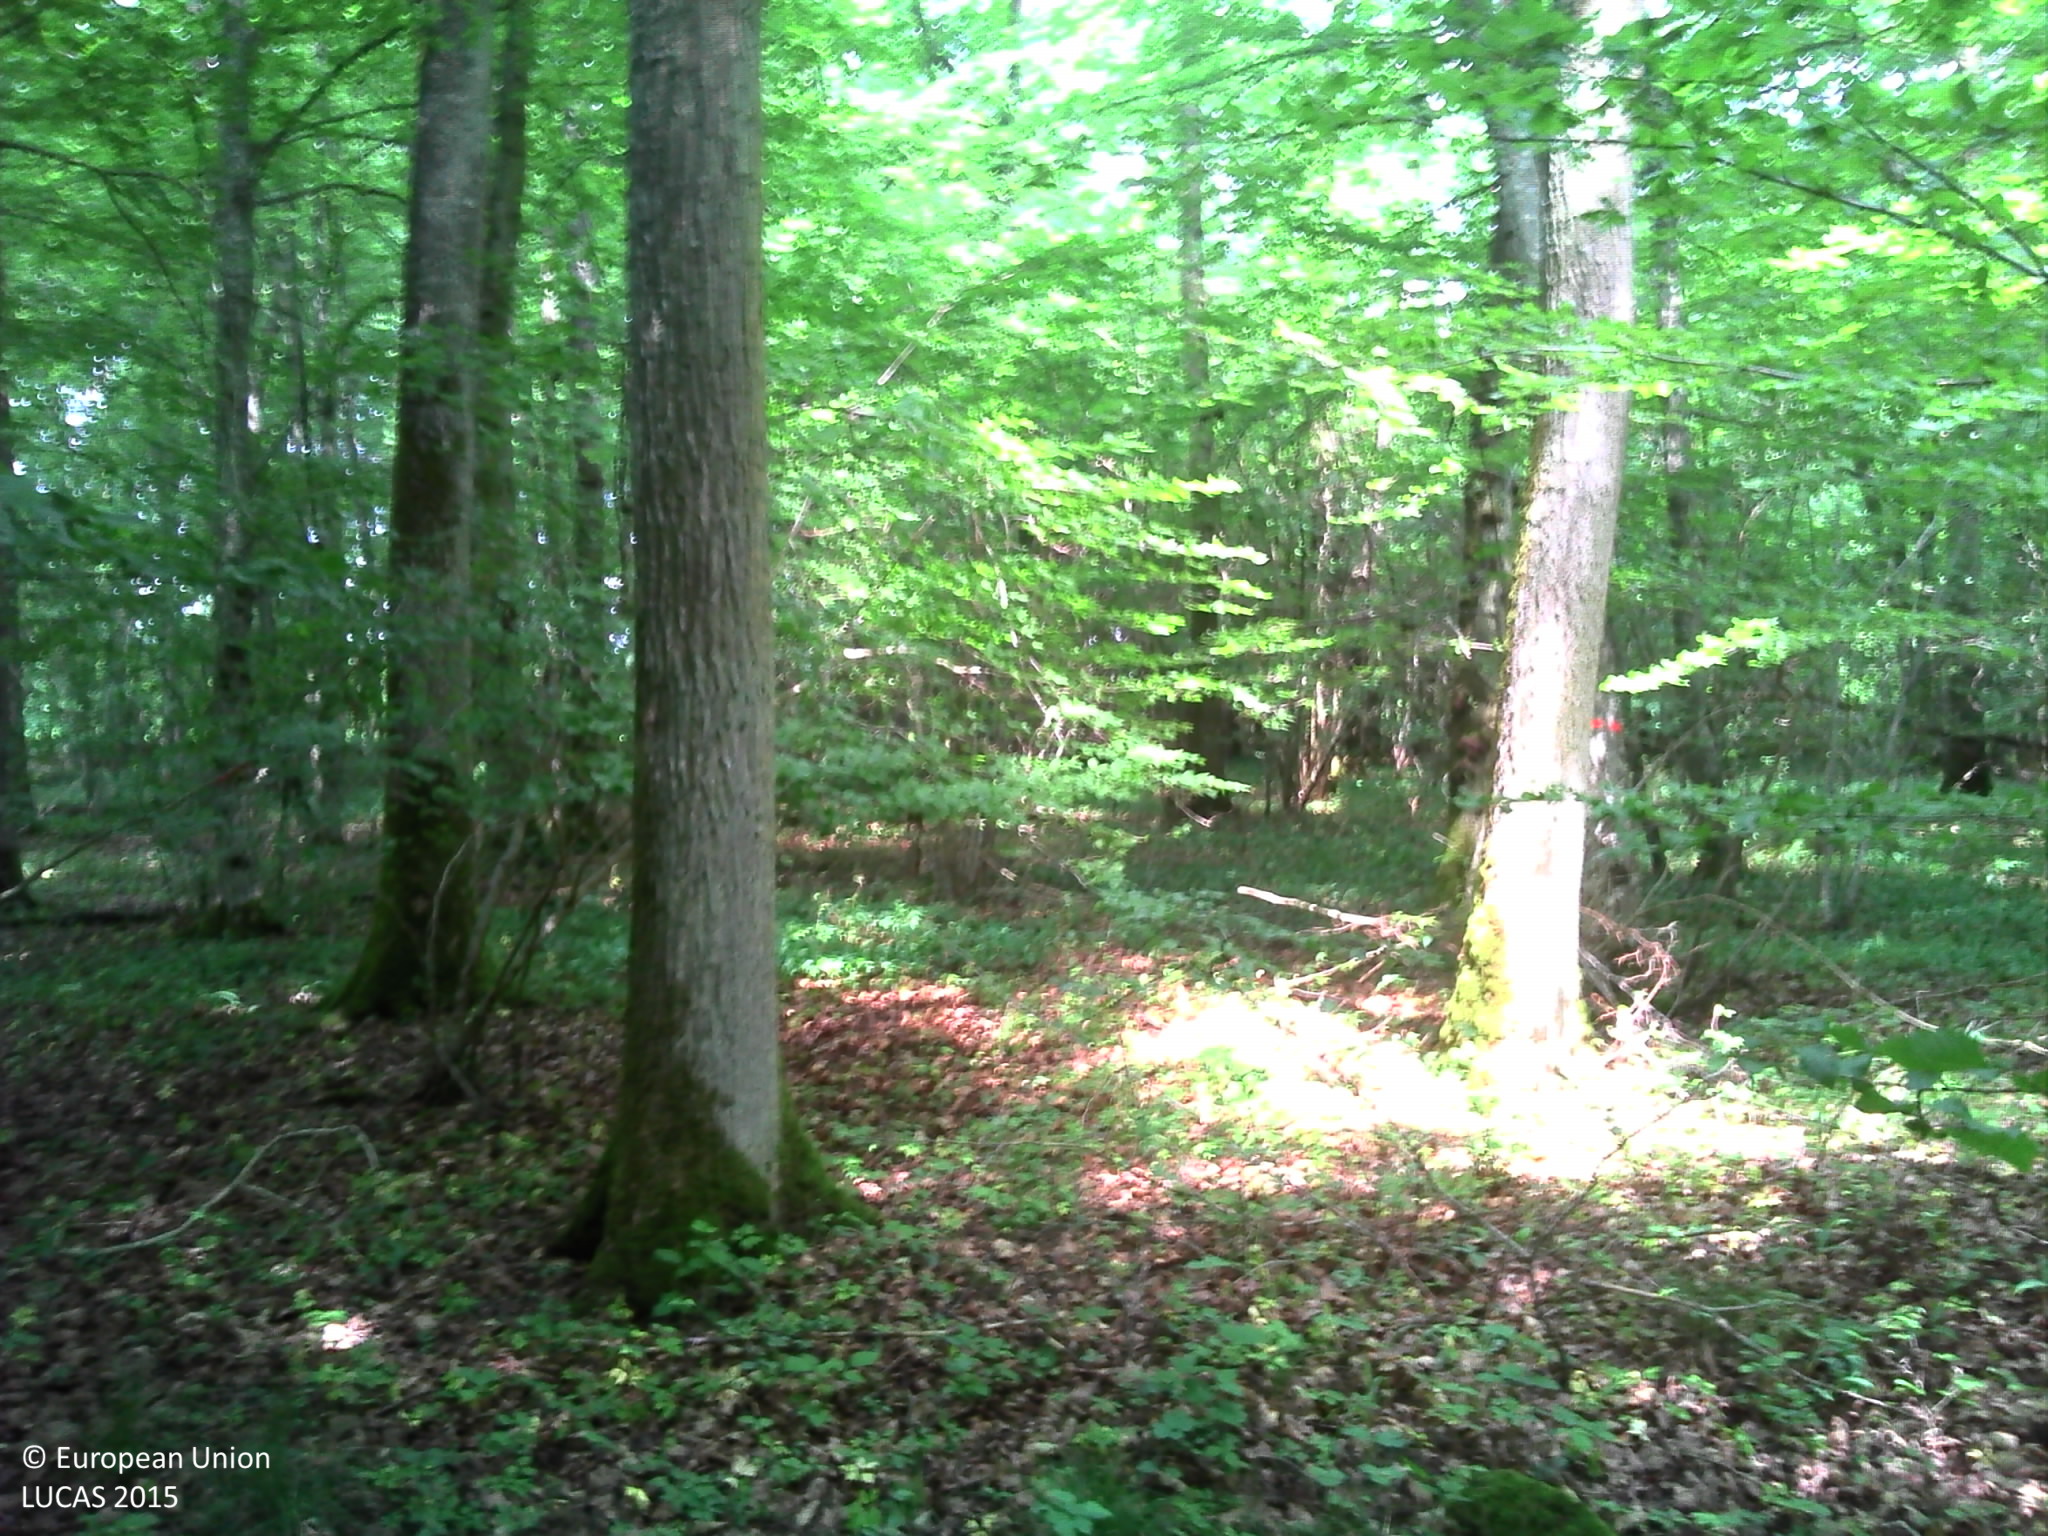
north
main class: Woodland
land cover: Broadleaved woodland
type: mesophytic deciduous forest
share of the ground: > 75 %
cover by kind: broadleaved forest trees 90 %, lichens and mosses 10 %
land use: Forestry
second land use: Amenities, museums, leisure
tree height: > 5 m
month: June
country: FR
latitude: 48.7251
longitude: 5.9351
